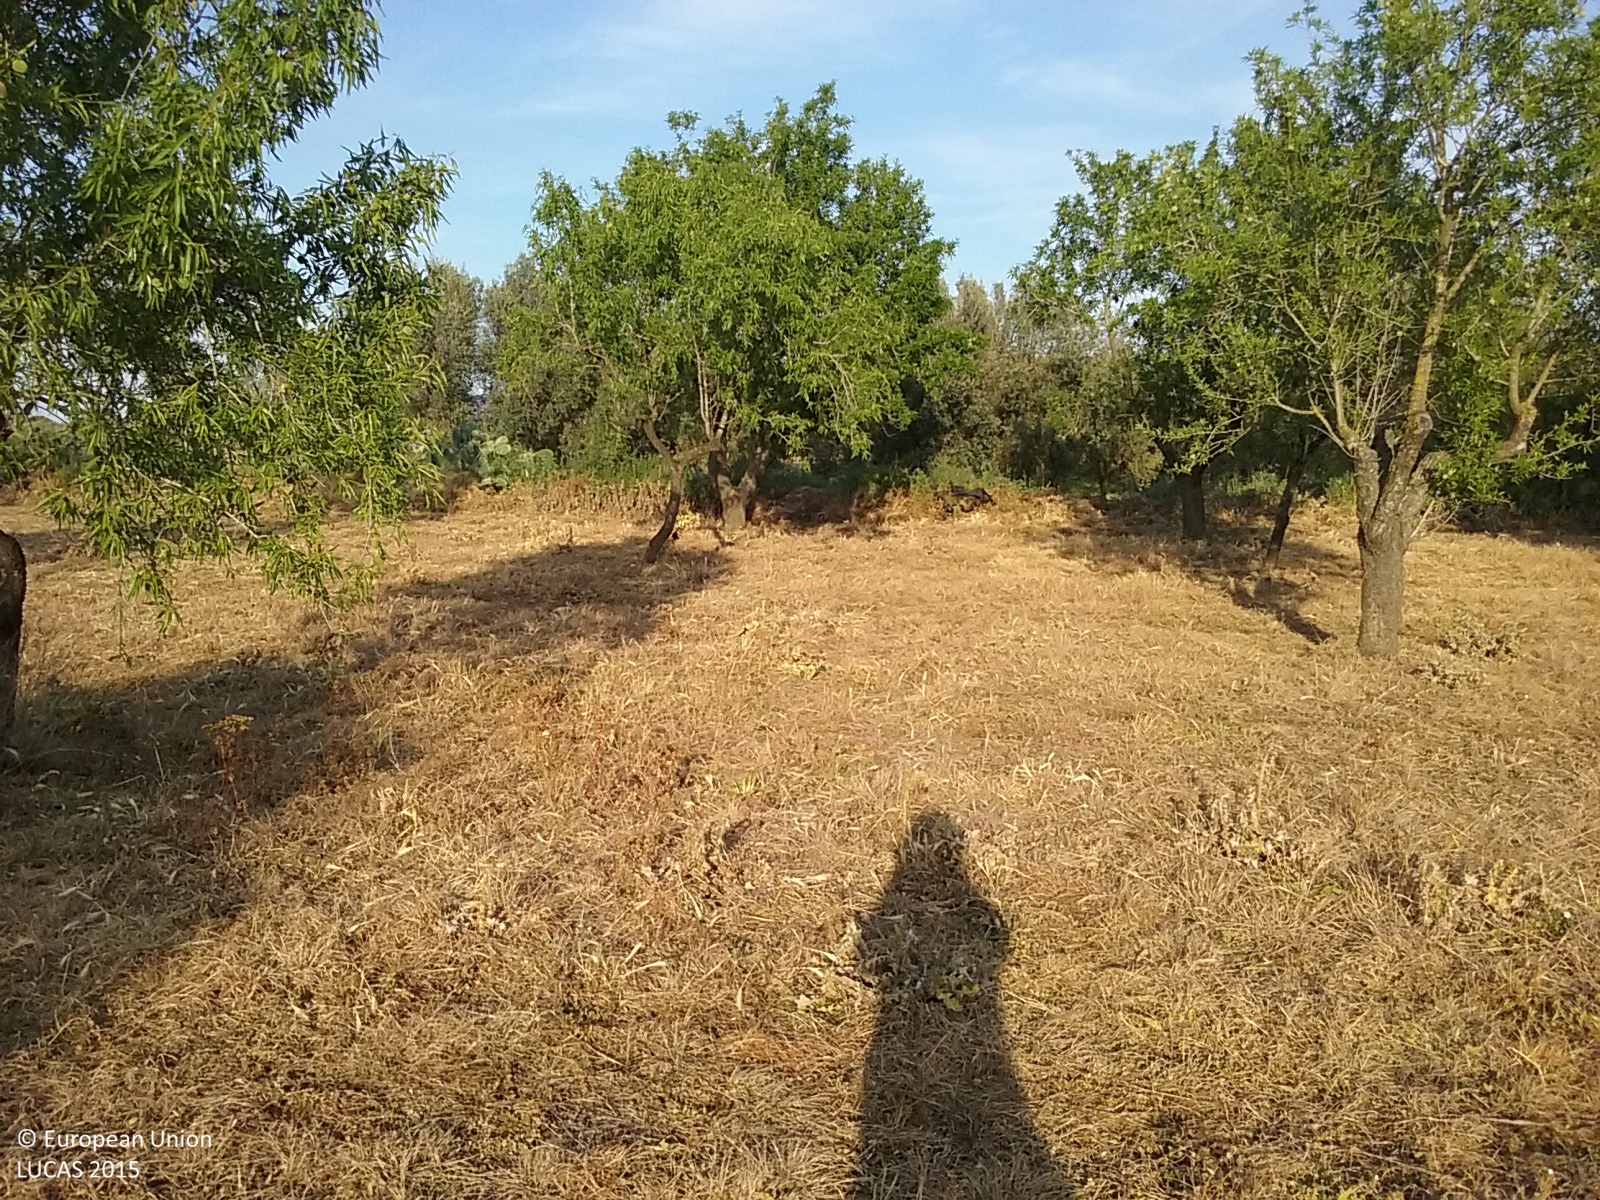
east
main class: Cropland
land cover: Nuts trees
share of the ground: 25 - 50 %
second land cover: Grassland without tree/shrub cover
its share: > 75 %
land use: Agriculture (excluding fallow land and kitchen gardens)
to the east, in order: Nuts trees; Grassland without tree/shrub cover; Dry stone walls; Olive groves; Dry stone walls; Common wheat; Dry stone walls; Olive groves
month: April
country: ES
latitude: 40.6313
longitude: 0.3829
